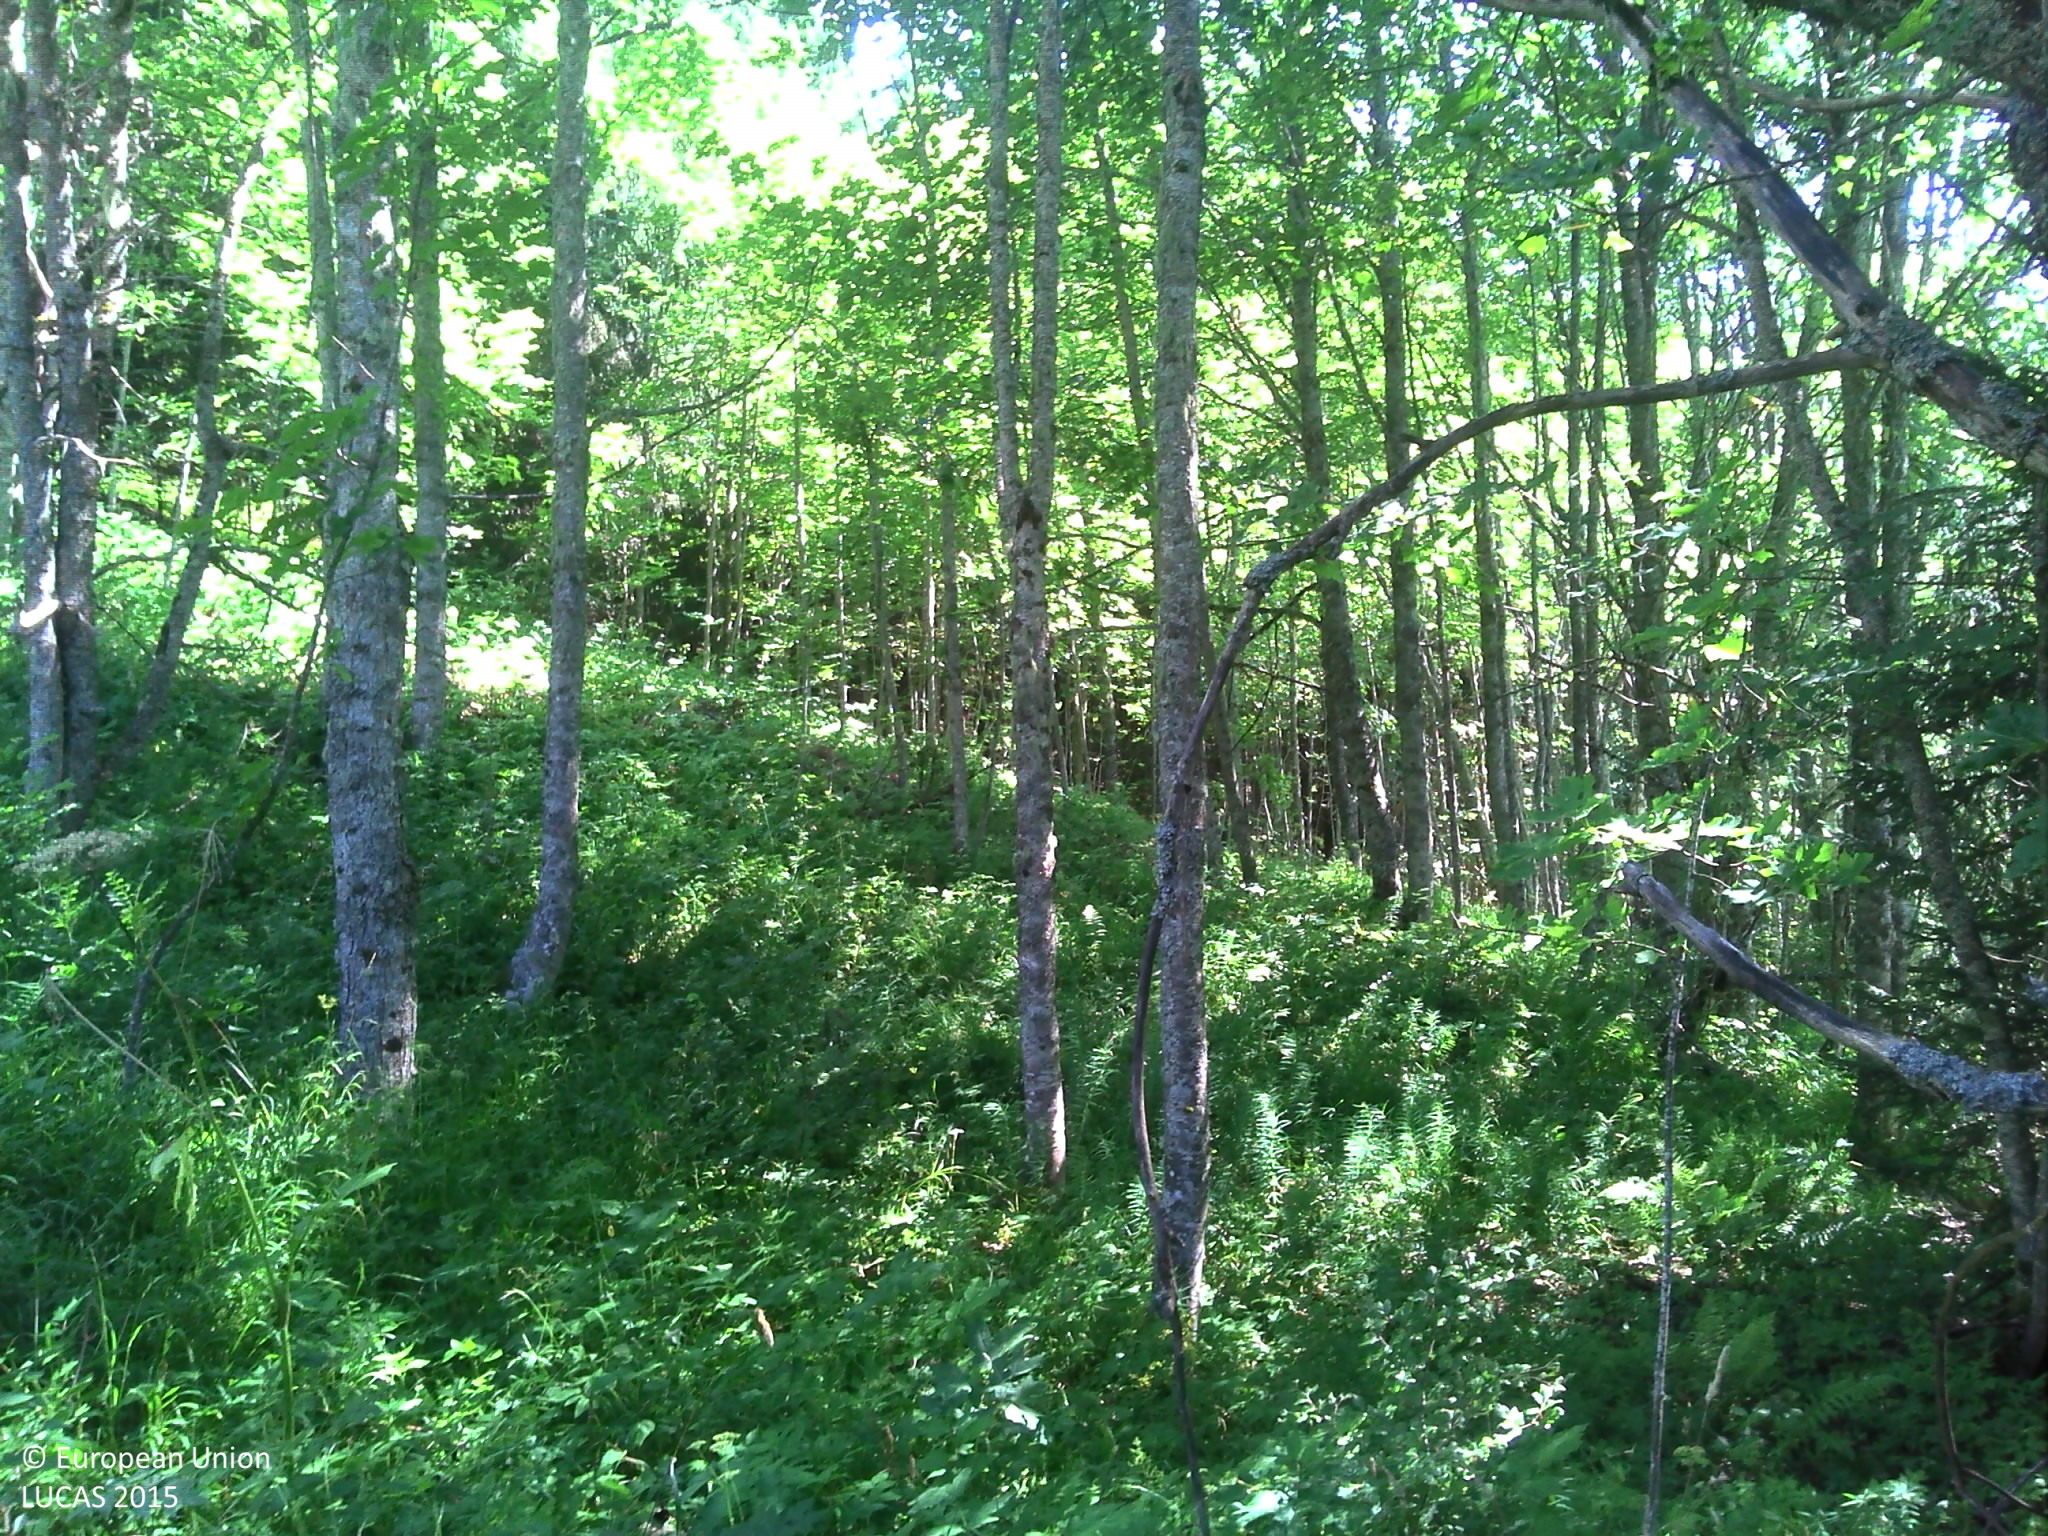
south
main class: Woodland
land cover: Broadleaved woodland
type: mountainous beech forest
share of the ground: > 75 %
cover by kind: broadleaved forest trees 50 %, herbaceous plants 30 %, coniferous forest trees 15 %, lichens and mosses 5 %
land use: Forestry
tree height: > 5 m
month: July
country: FR
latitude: 45.8951
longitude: 6.4339
